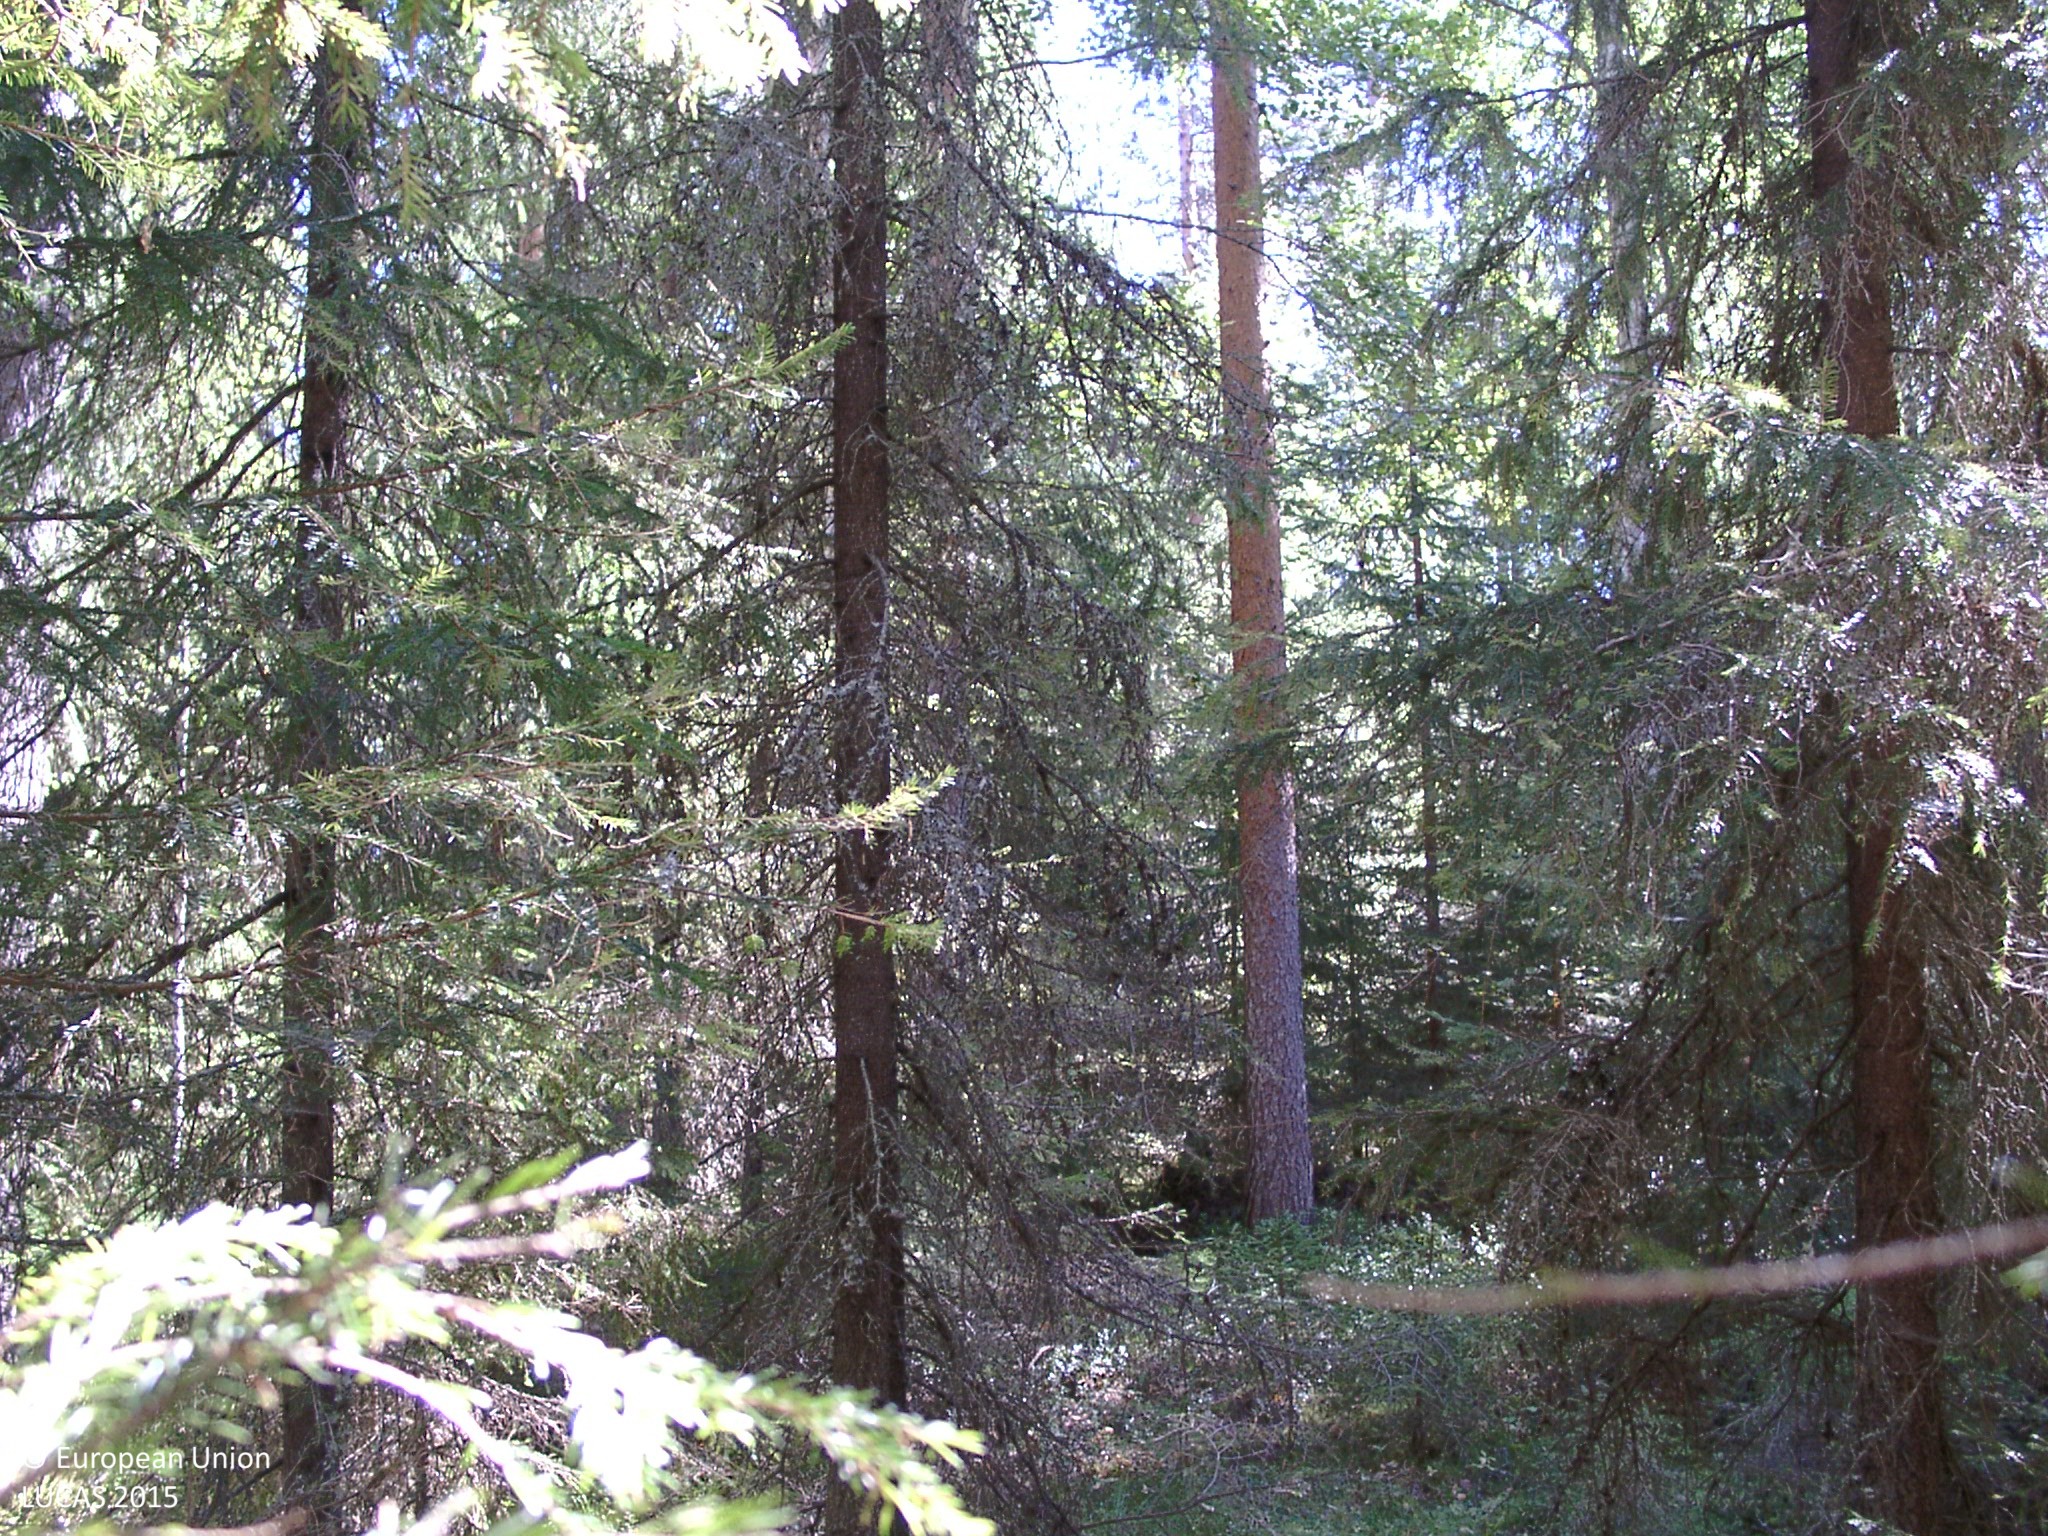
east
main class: Woodland
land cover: Other coniferous woodland
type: boreal forest
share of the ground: > 75 %
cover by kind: coniferous forest trees 65 %, broadleaved forest trees 20 %, shrubs 10 %, lichens and mosses 5 %
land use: Forestry
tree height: > 5 m
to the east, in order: Other coniferous woodland; Ditches and canals; Other mixed woodland; Ditches and canals; Other coniferous woodland; Ditches and canals; Spruce dominated mixed woodland; Other mixed woodland; Spruce dominated mixed woodland; Spruce dominated coniferous woodland; Tracks; Spruce dominated coniferous woodland; Spruce dominated mixed woodland
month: August
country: FI
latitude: 61.9300
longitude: 24.9834
